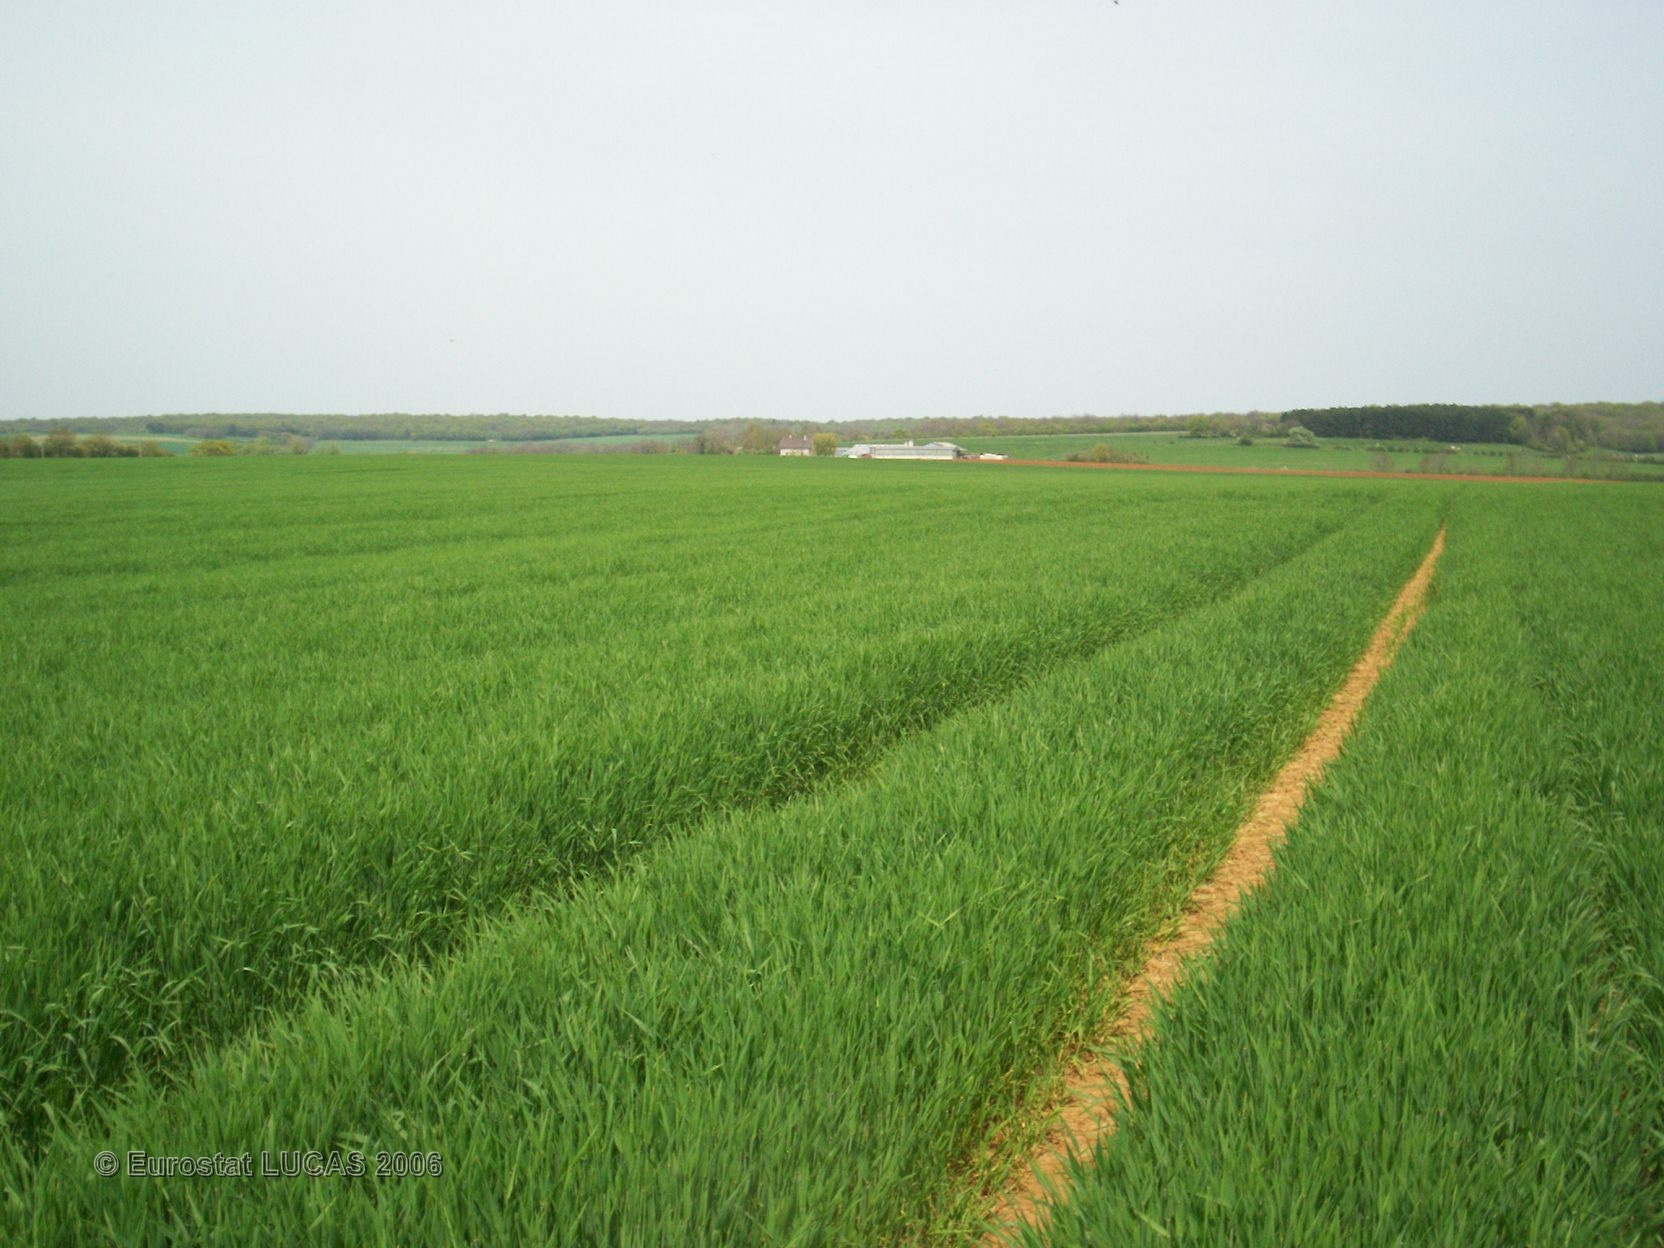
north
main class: Cropland
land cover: Barley
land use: Agriculture (excluding fallow land and kitchen gardens)
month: May
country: FR
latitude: 47.6394
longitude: 4.5816
